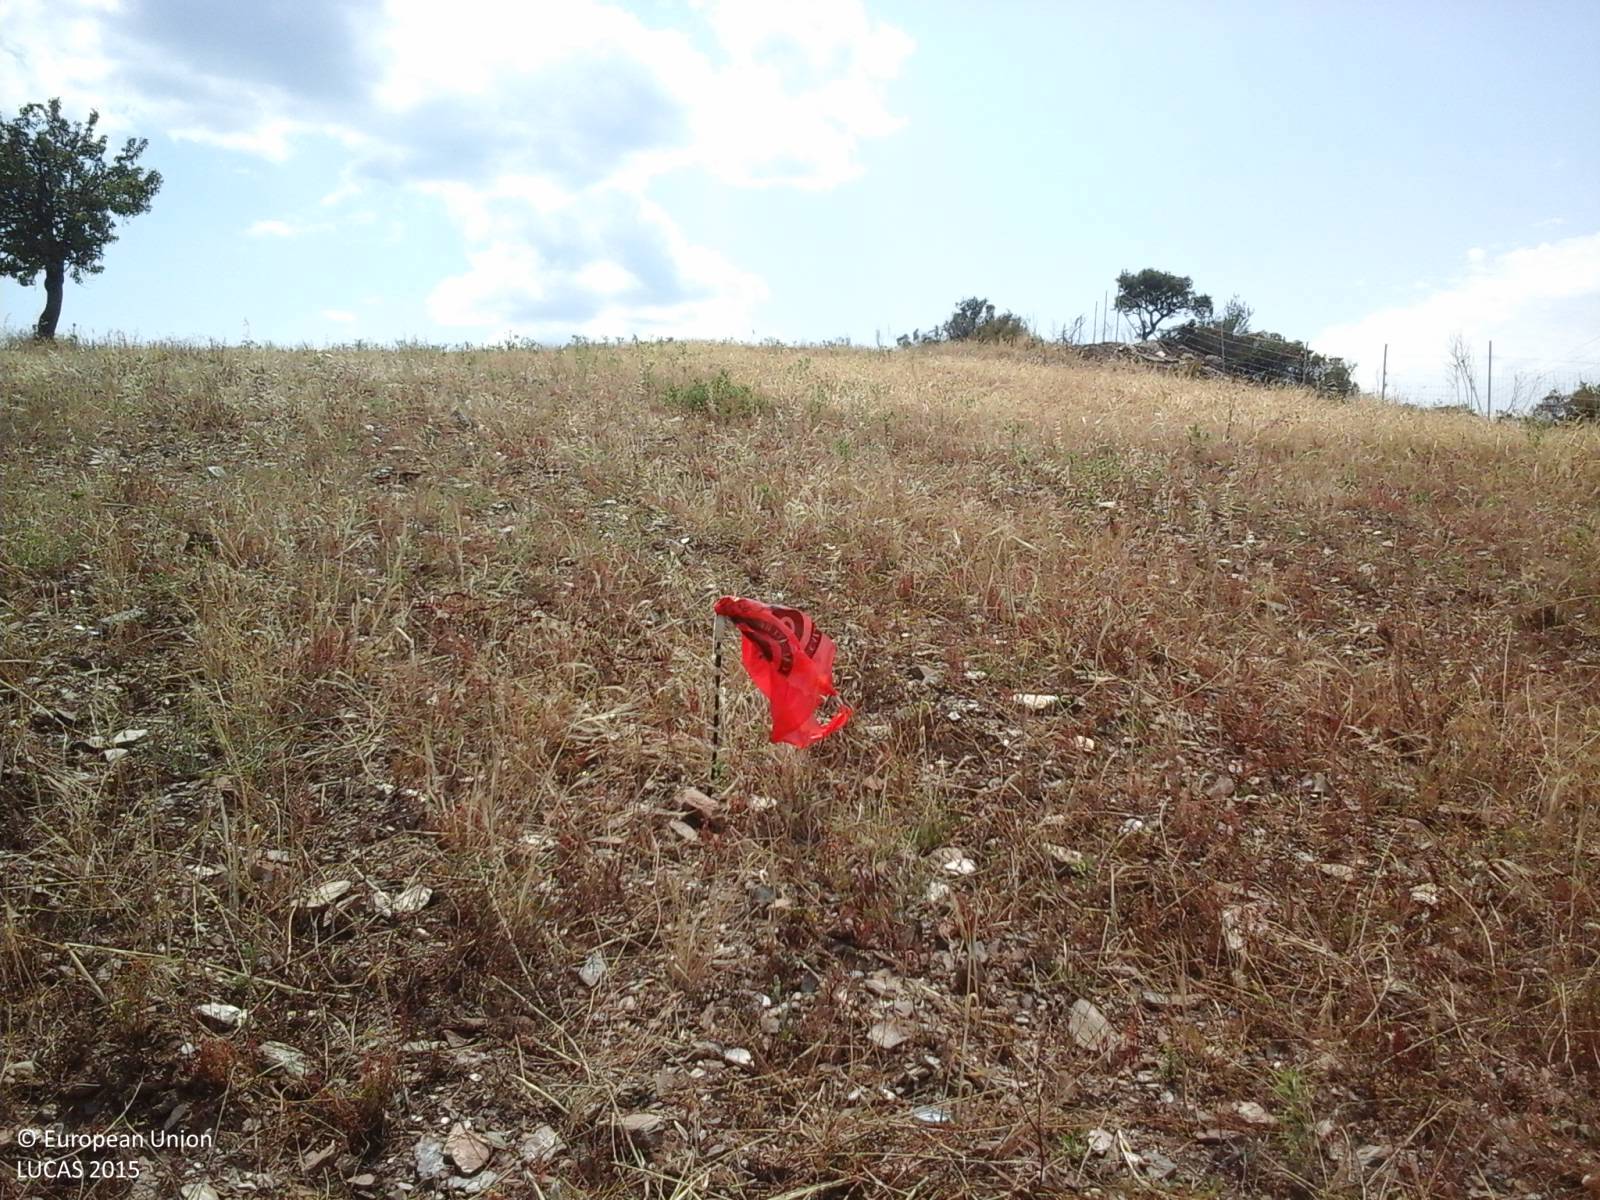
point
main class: Cropland
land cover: Mixed cereals for fodder
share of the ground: > 75 %
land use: Agriculture (excluding fallow land and kitchen gardens)
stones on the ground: > 50 %
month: June
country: IT
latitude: 40.4469
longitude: 9.4721
